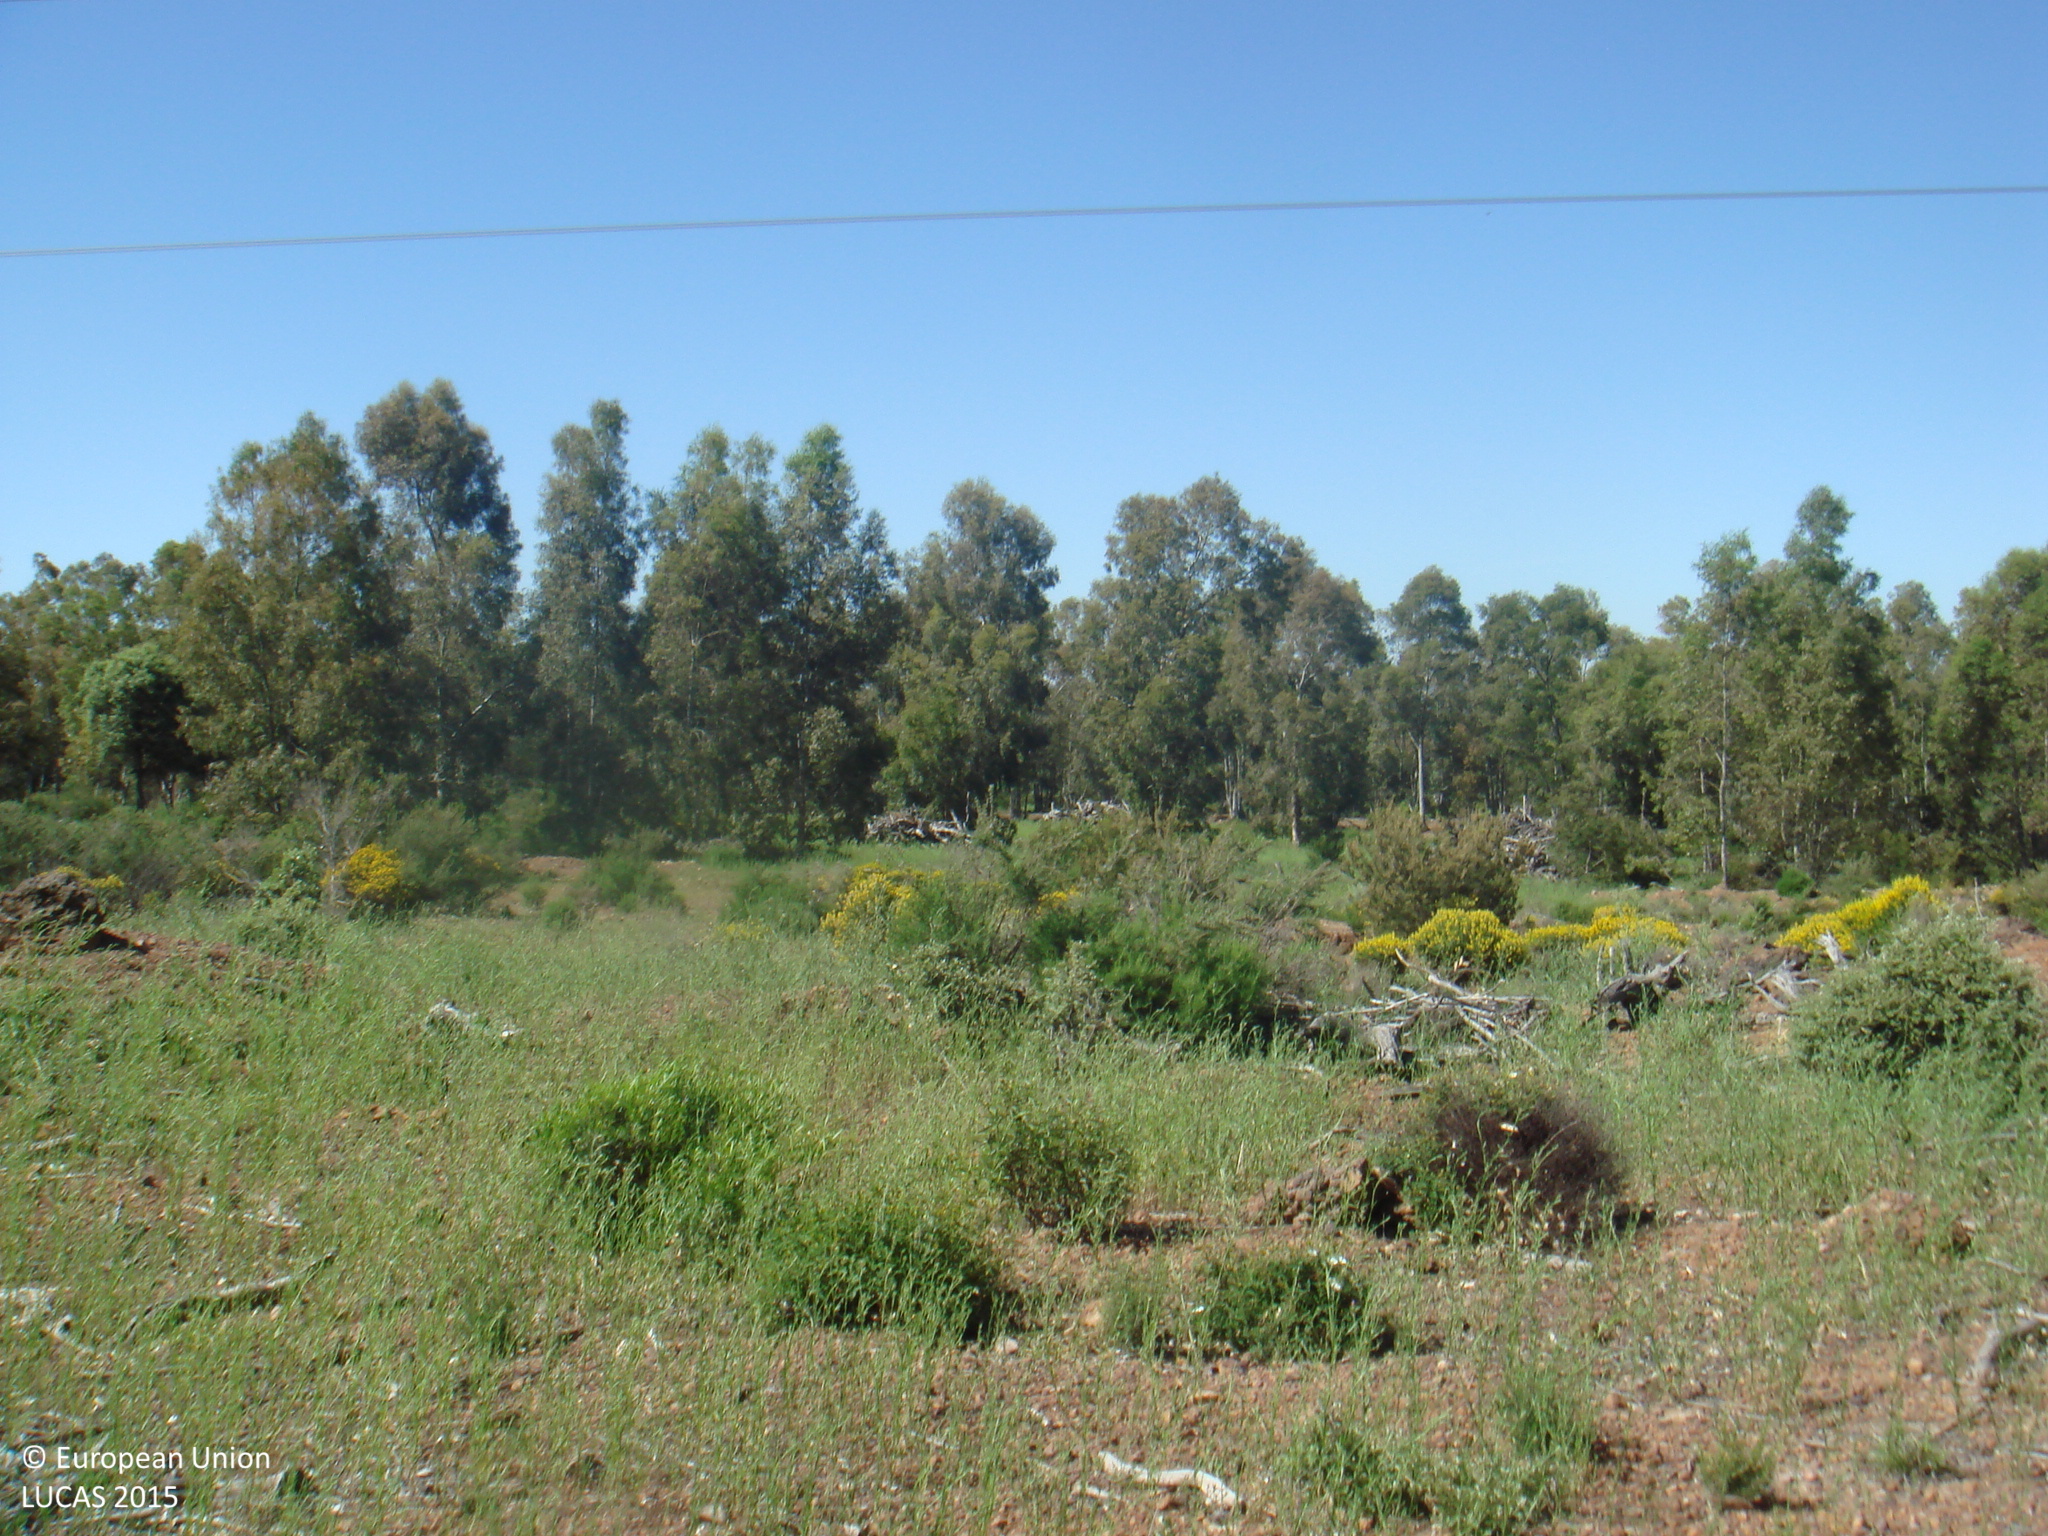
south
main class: Woodland
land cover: Broadleaved woodland
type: broadleaved evergreen forest
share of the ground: > 75 %
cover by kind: broadleaved forest trees 50 %, herbaceous plants 30 %, shrubs 20 %
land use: Forestry
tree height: > 5 m
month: May
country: ES
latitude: 38.4575
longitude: -4.4468
